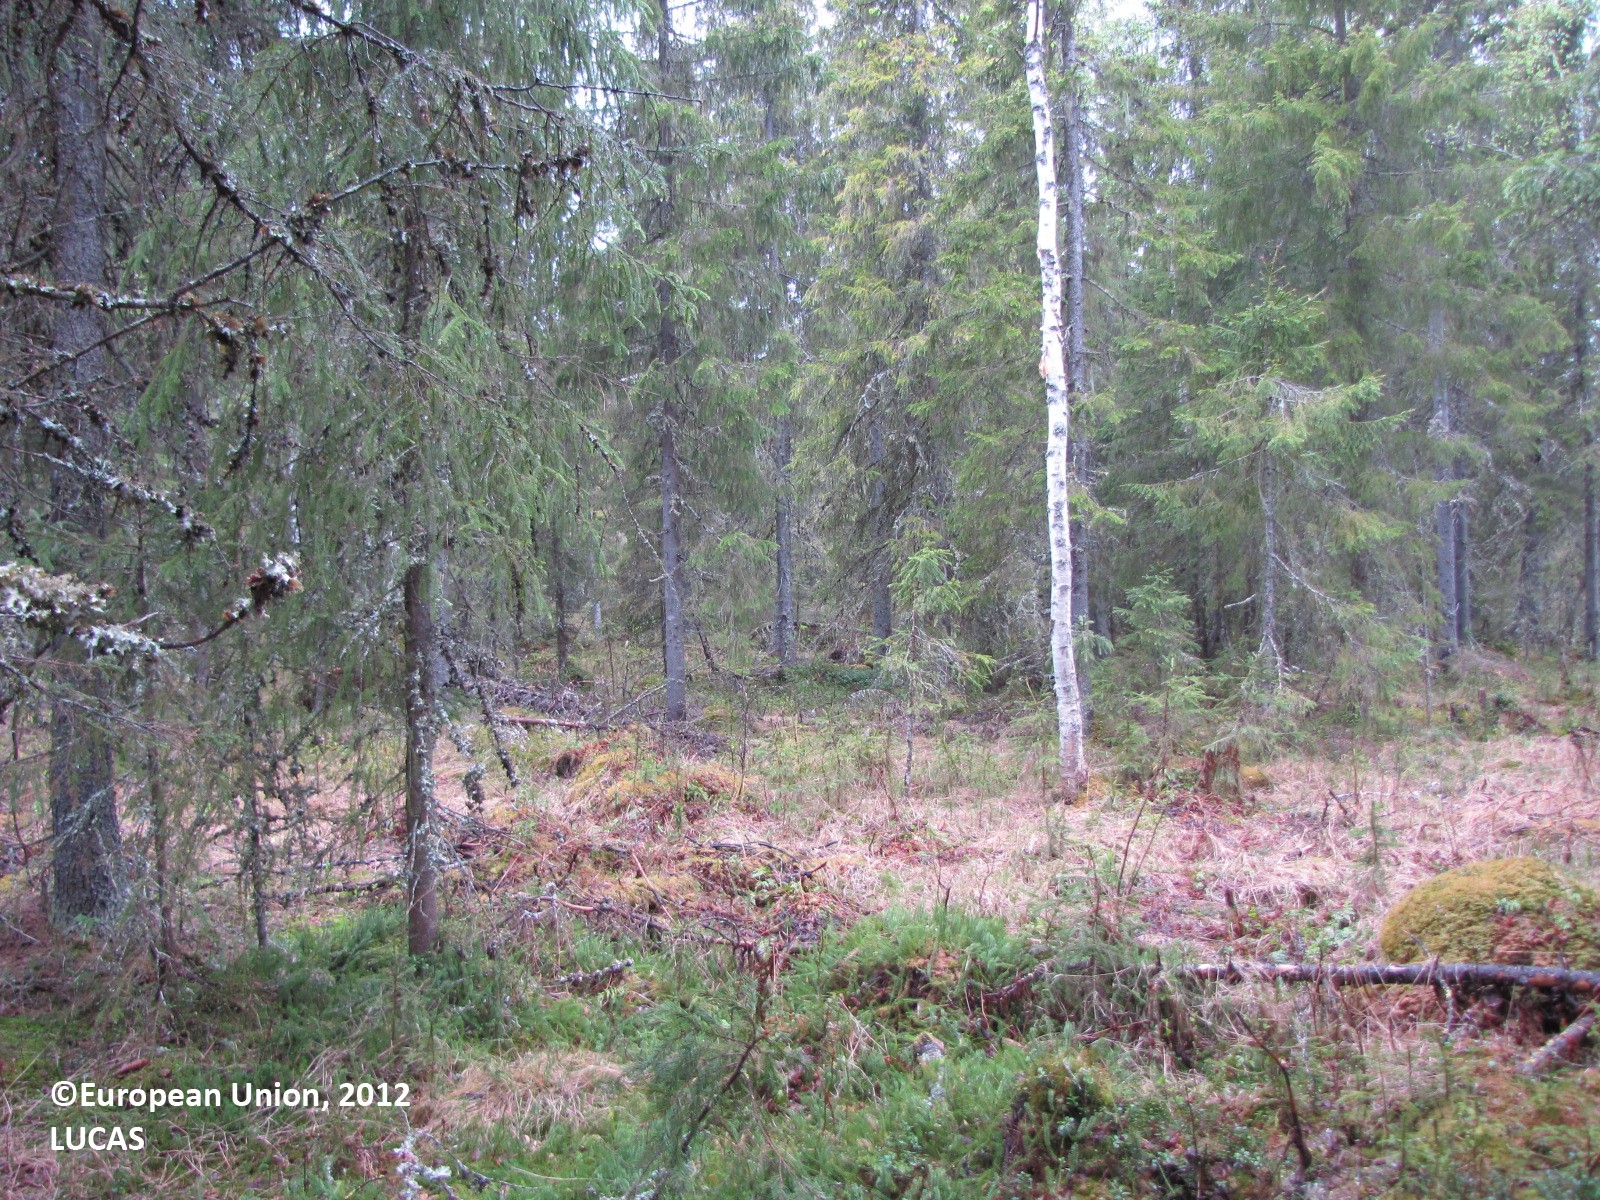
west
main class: Woodland
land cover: Spruce dominated coniferous woodland
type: boreal forest
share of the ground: 50 - 75 %
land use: Forestry
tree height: > 5 m
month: June
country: FI
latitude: 65.9556
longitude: 24.5473
